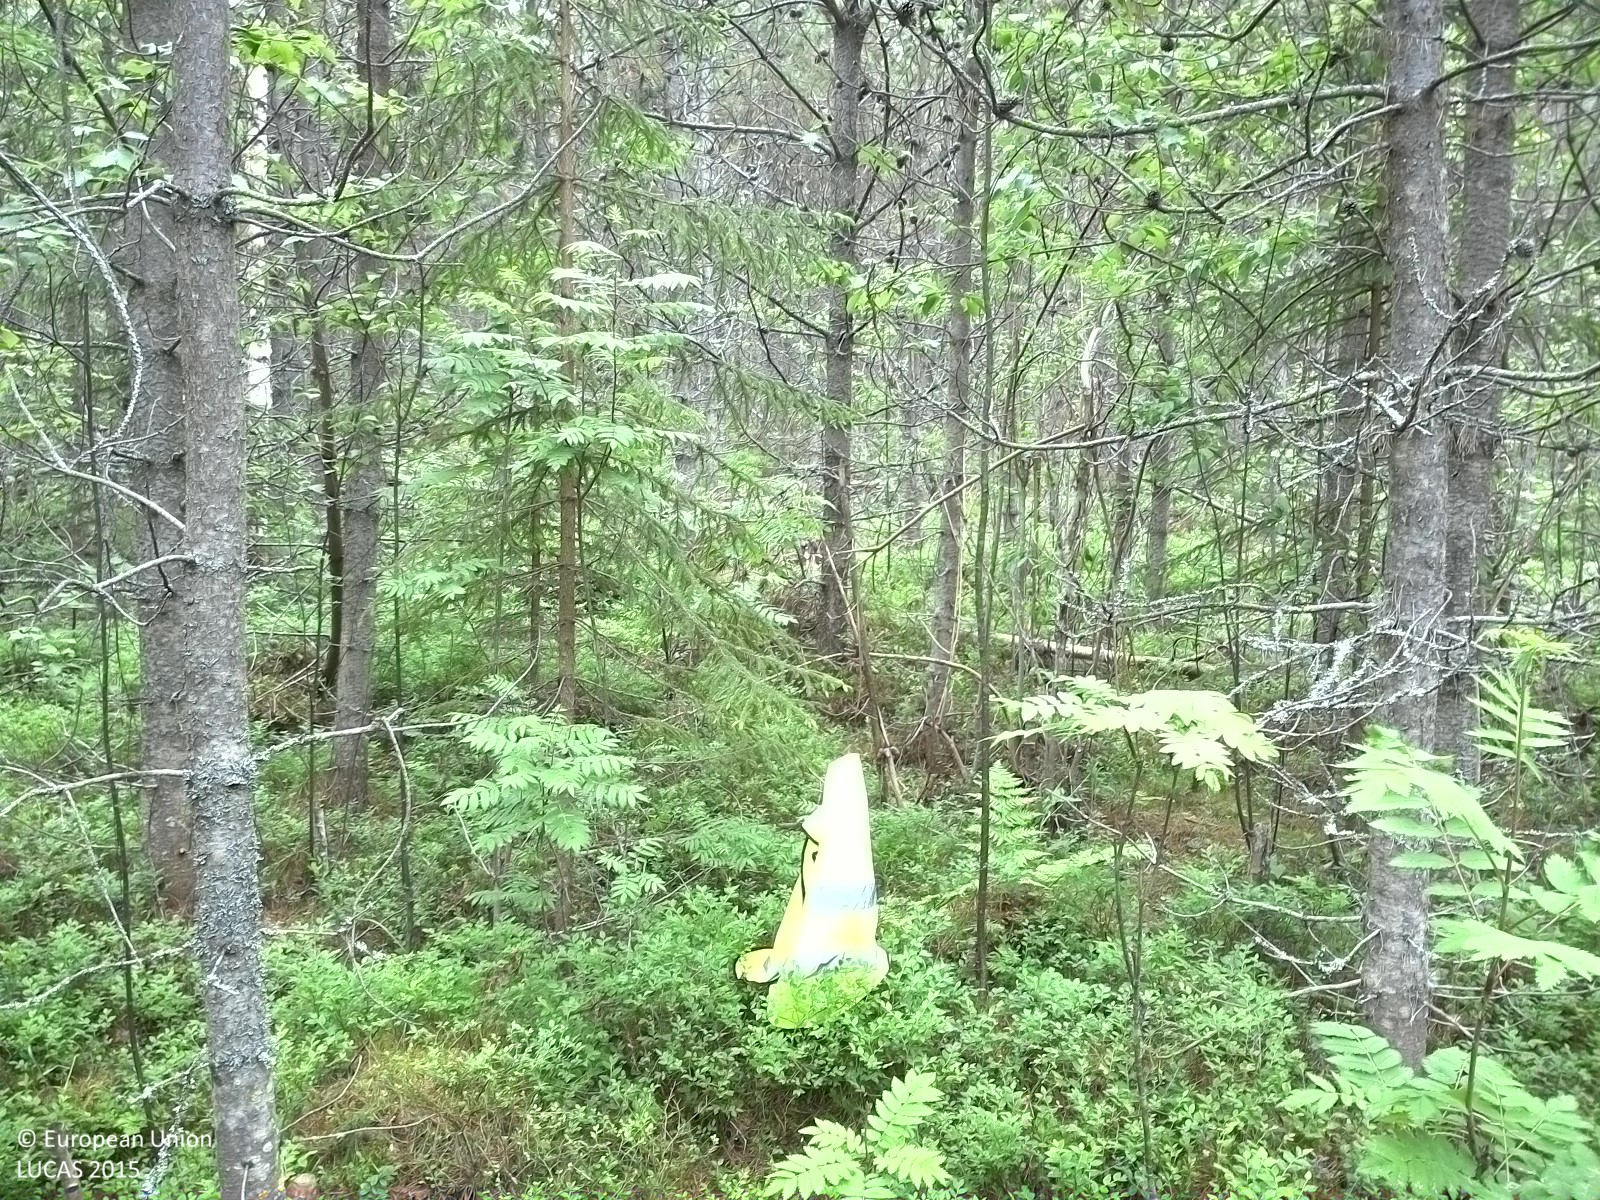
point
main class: Woodland
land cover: Pine dominated coniferous woodland
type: exotic forest
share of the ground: > 75 %
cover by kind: coniferous forest trees 75 %, shrubs 10 %, broadleaved forest trees 5 %, herbaceous plants 5 %, lichens and mosses 5 %
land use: Forestry
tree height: > 5 m
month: July
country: SE
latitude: 62.1339
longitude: 16.3673
